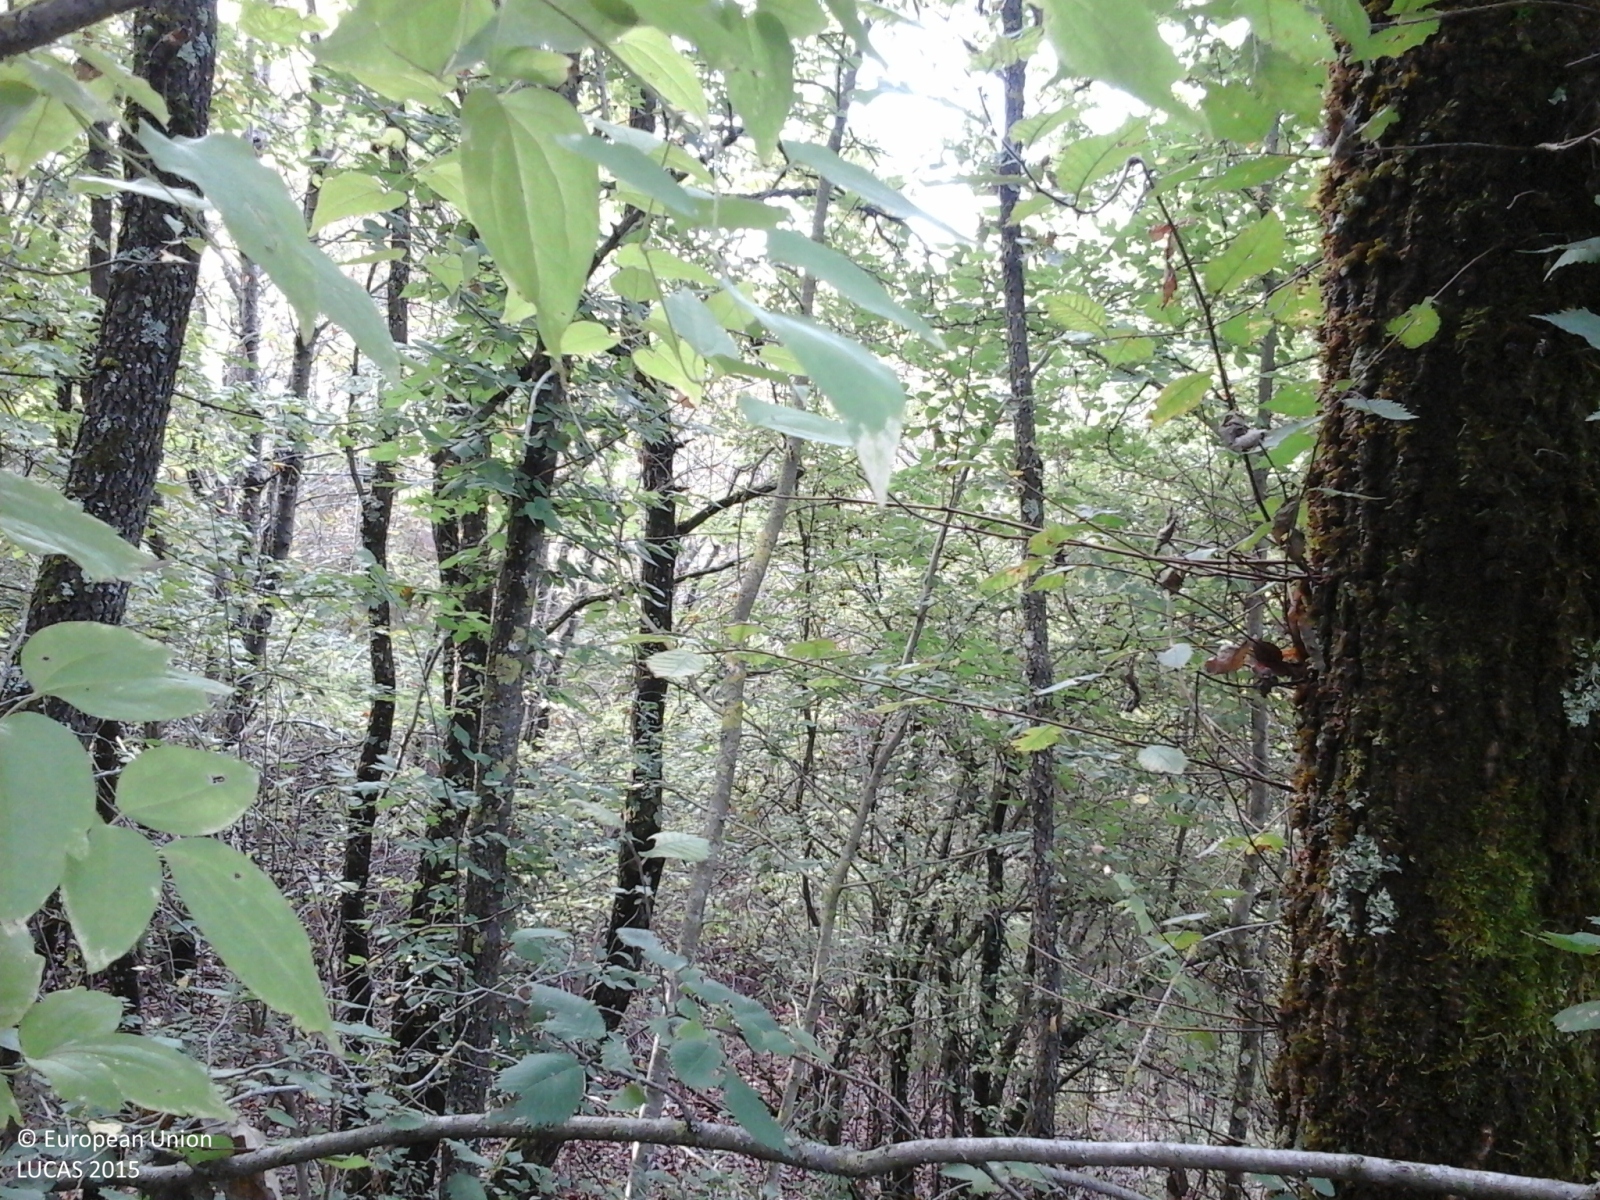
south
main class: Woodland
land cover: Broadleaved woodland
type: thermophilous deciduous forest
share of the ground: > 75 %
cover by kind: broadleaved forest trees 95 %, herbaceous plants 5 %
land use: Forestry
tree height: > 5 m
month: October
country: IT
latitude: 43.2706
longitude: 12.6172
